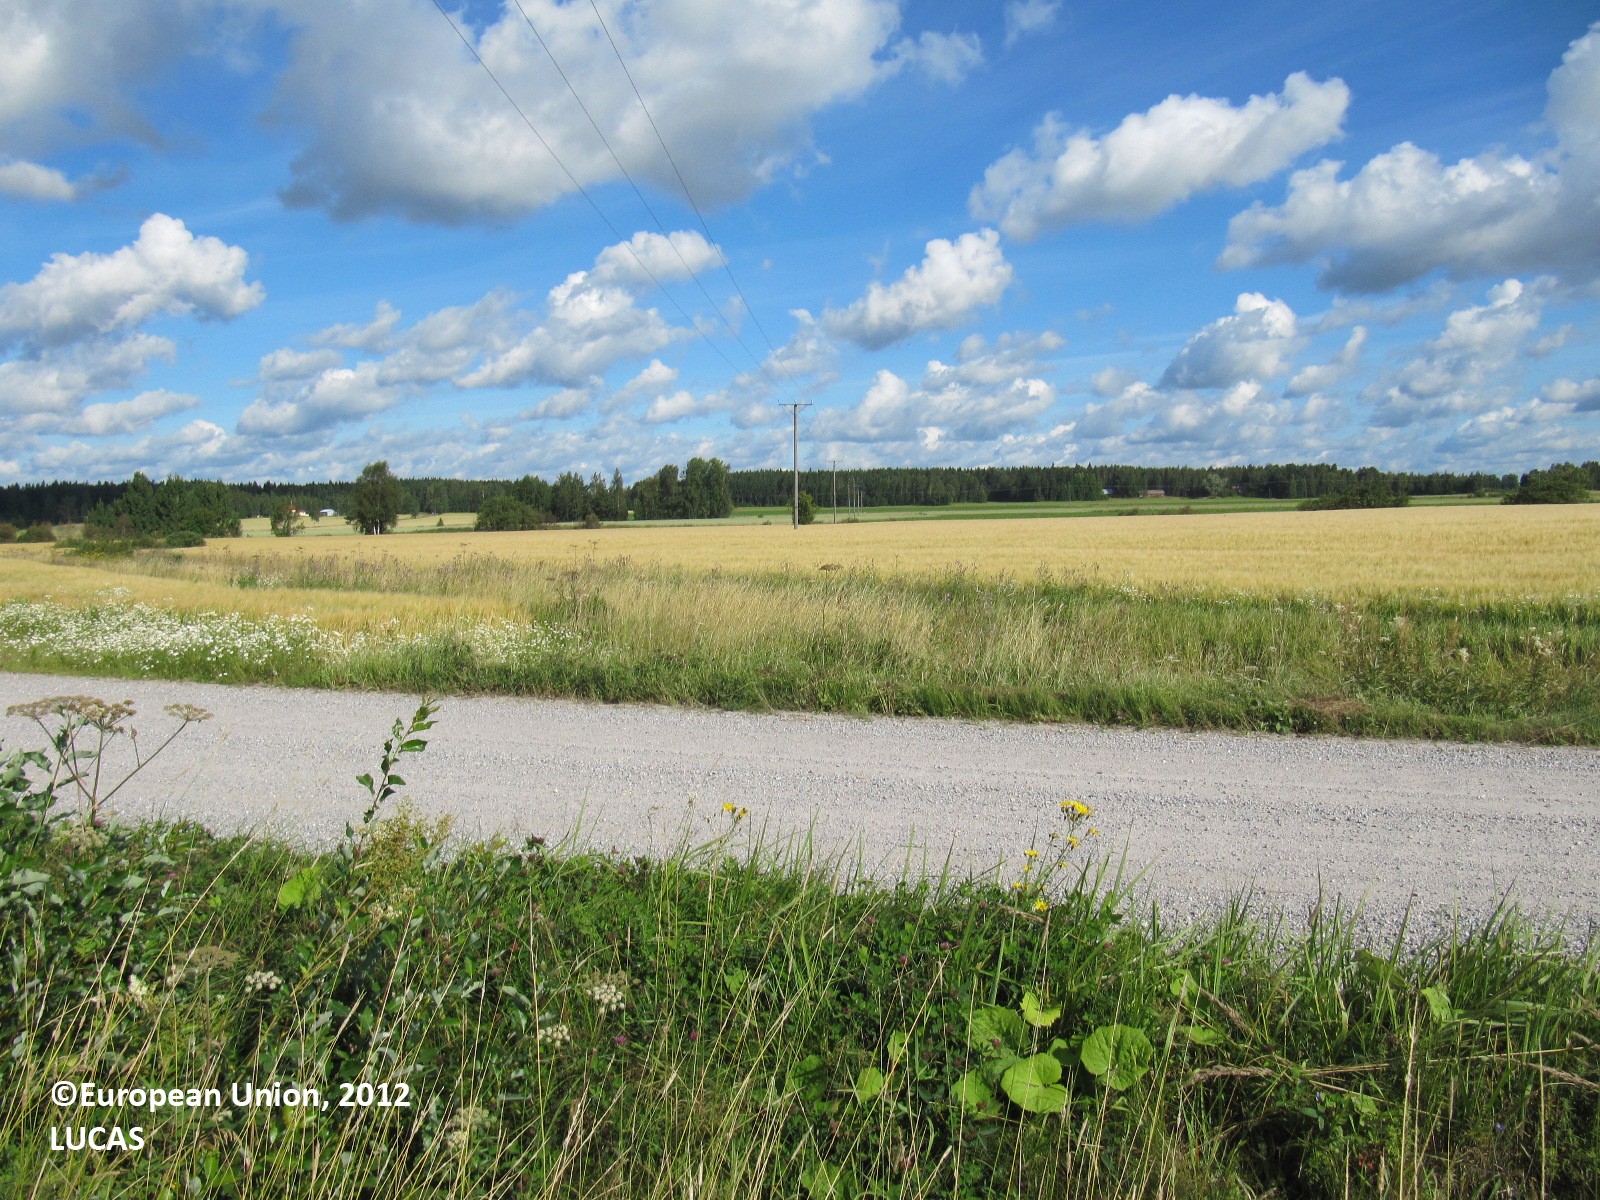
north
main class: Cropland
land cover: Common wheat
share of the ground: > 75 %
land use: Agriculture (excluding fallow land and kitchen gardens)
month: August
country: FI
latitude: 60.5103
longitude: 23.1748
